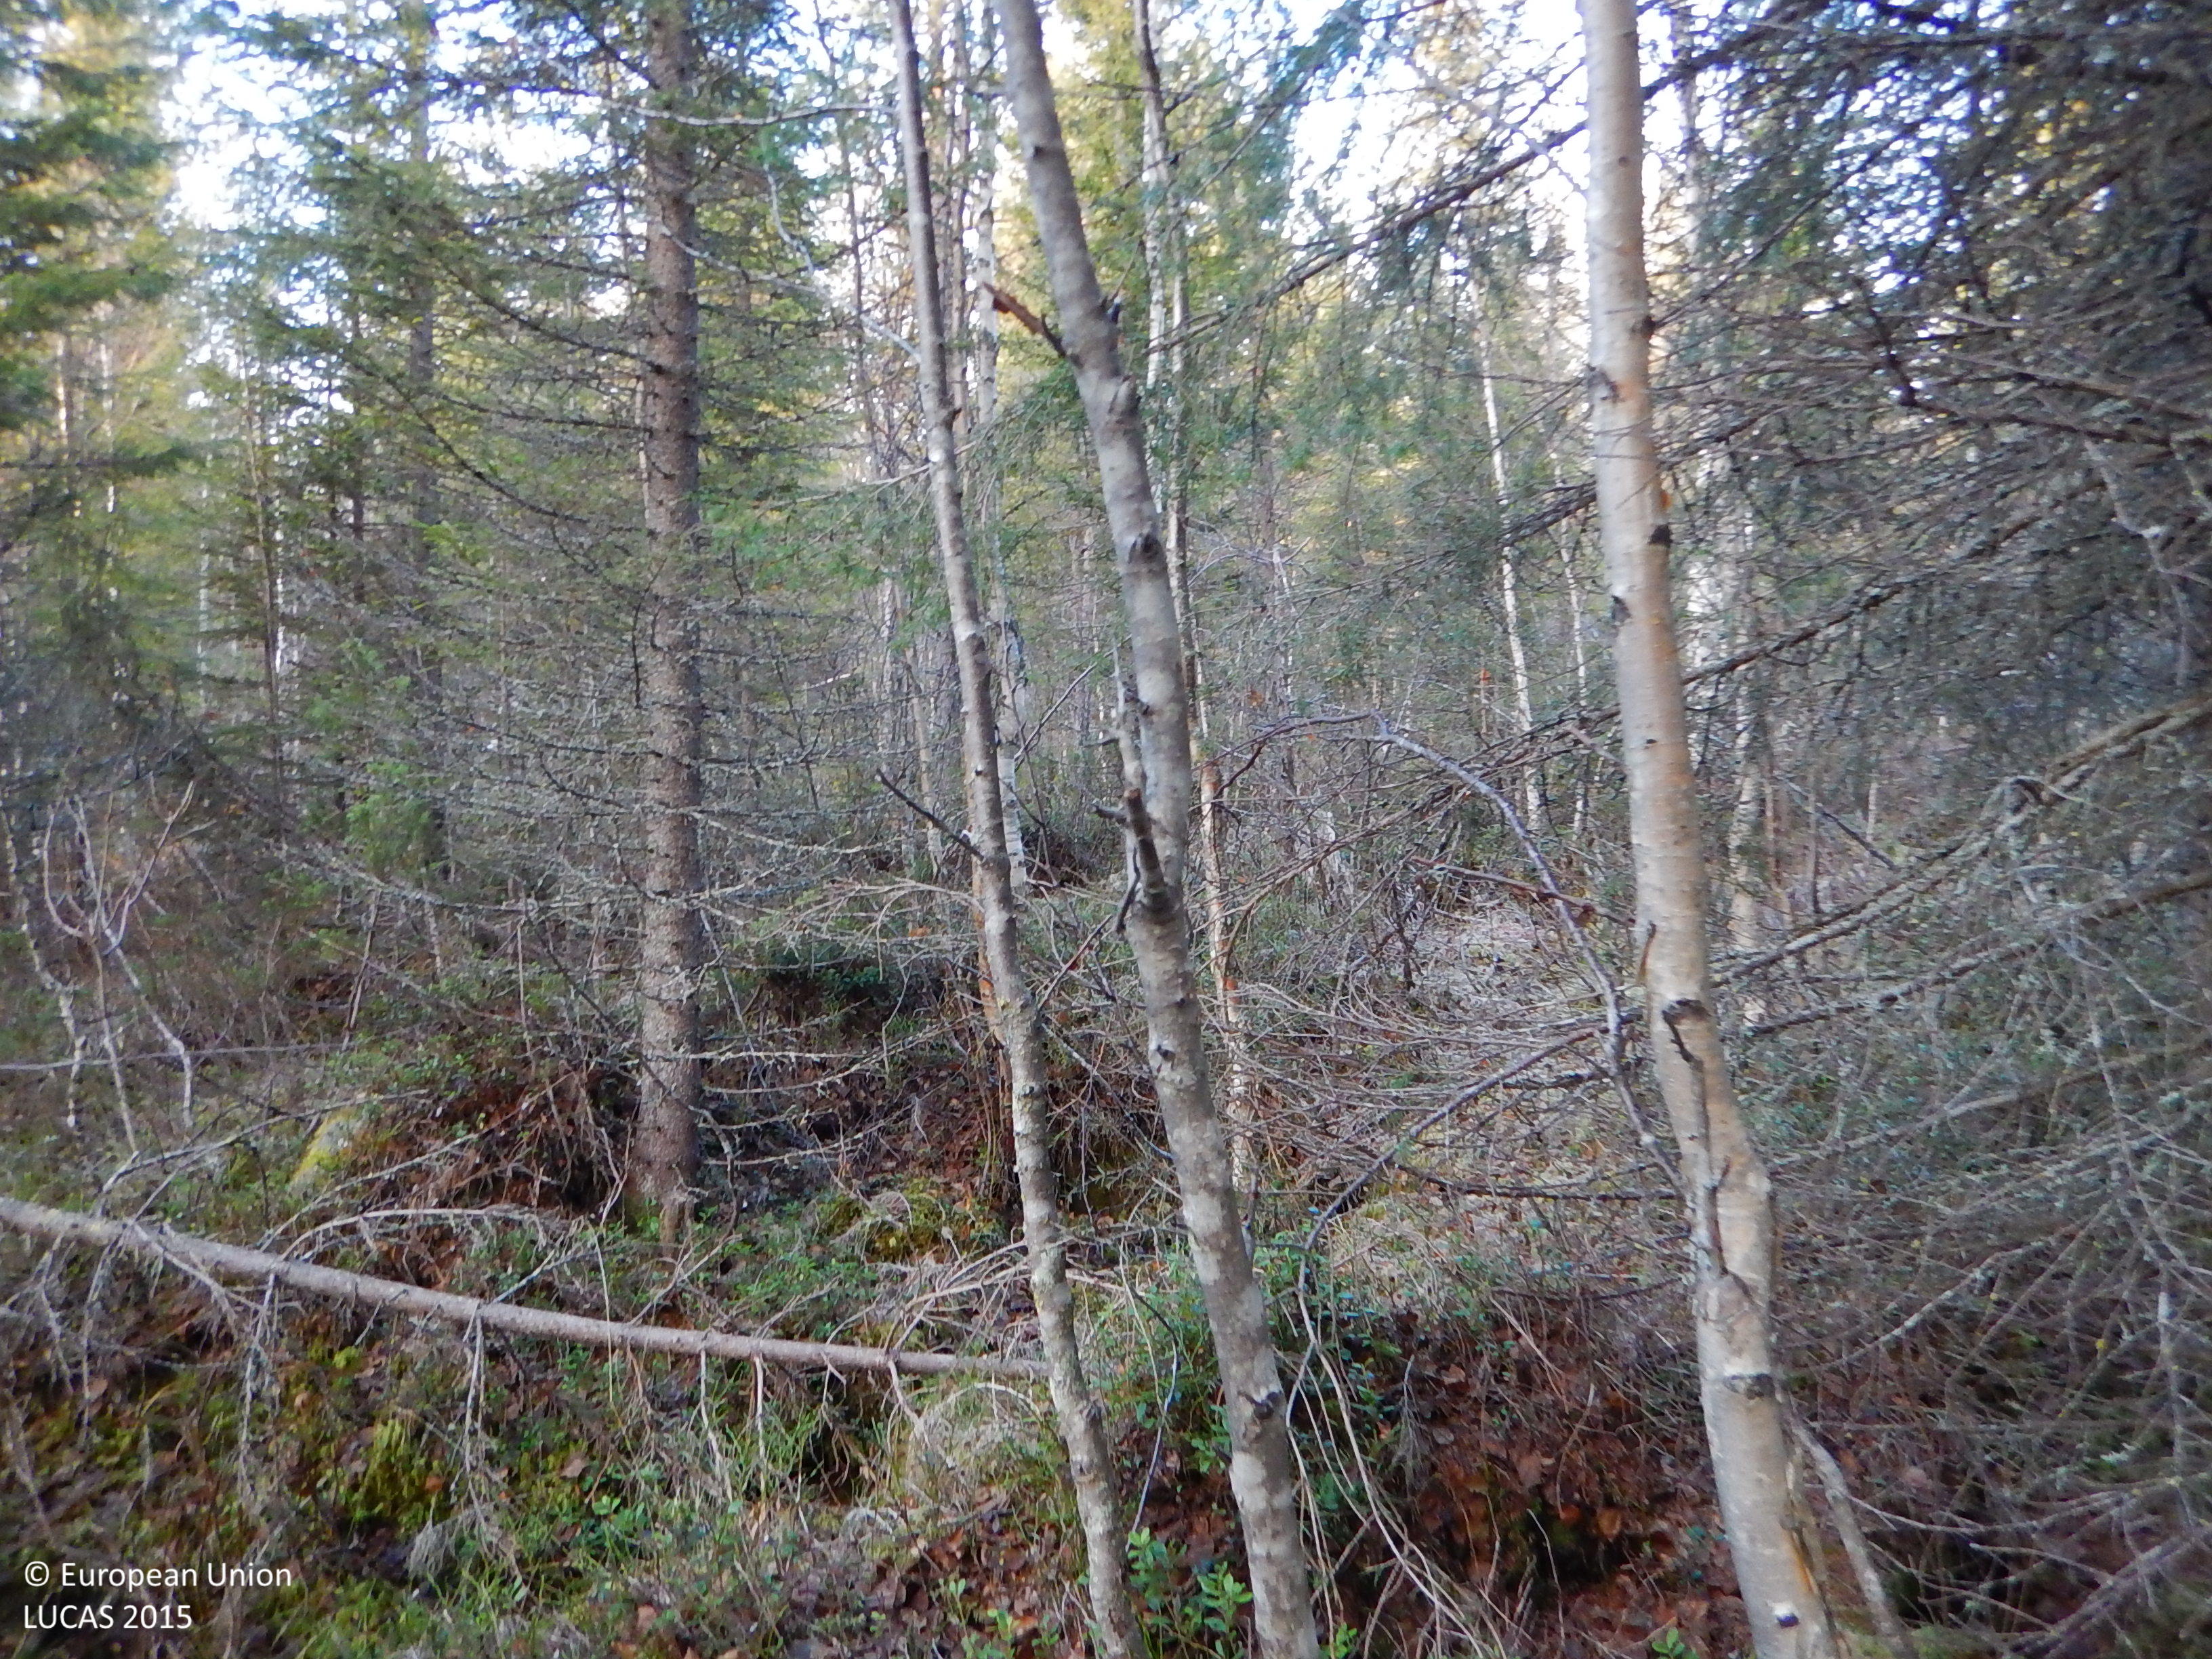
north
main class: Woodland
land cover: Spruce dominated mixed woodland
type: boreal forest
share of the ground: 50 - 75 %
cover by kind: coniferous forest trees 40 %, broadleaved forest trees 20 %, lichens and mosses 20 %, shrubs 10 %, herbaceous plants 10 %
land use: Forestry
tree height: > 5 m
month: November
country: SE
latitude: 65.2320
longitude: 20.5594
